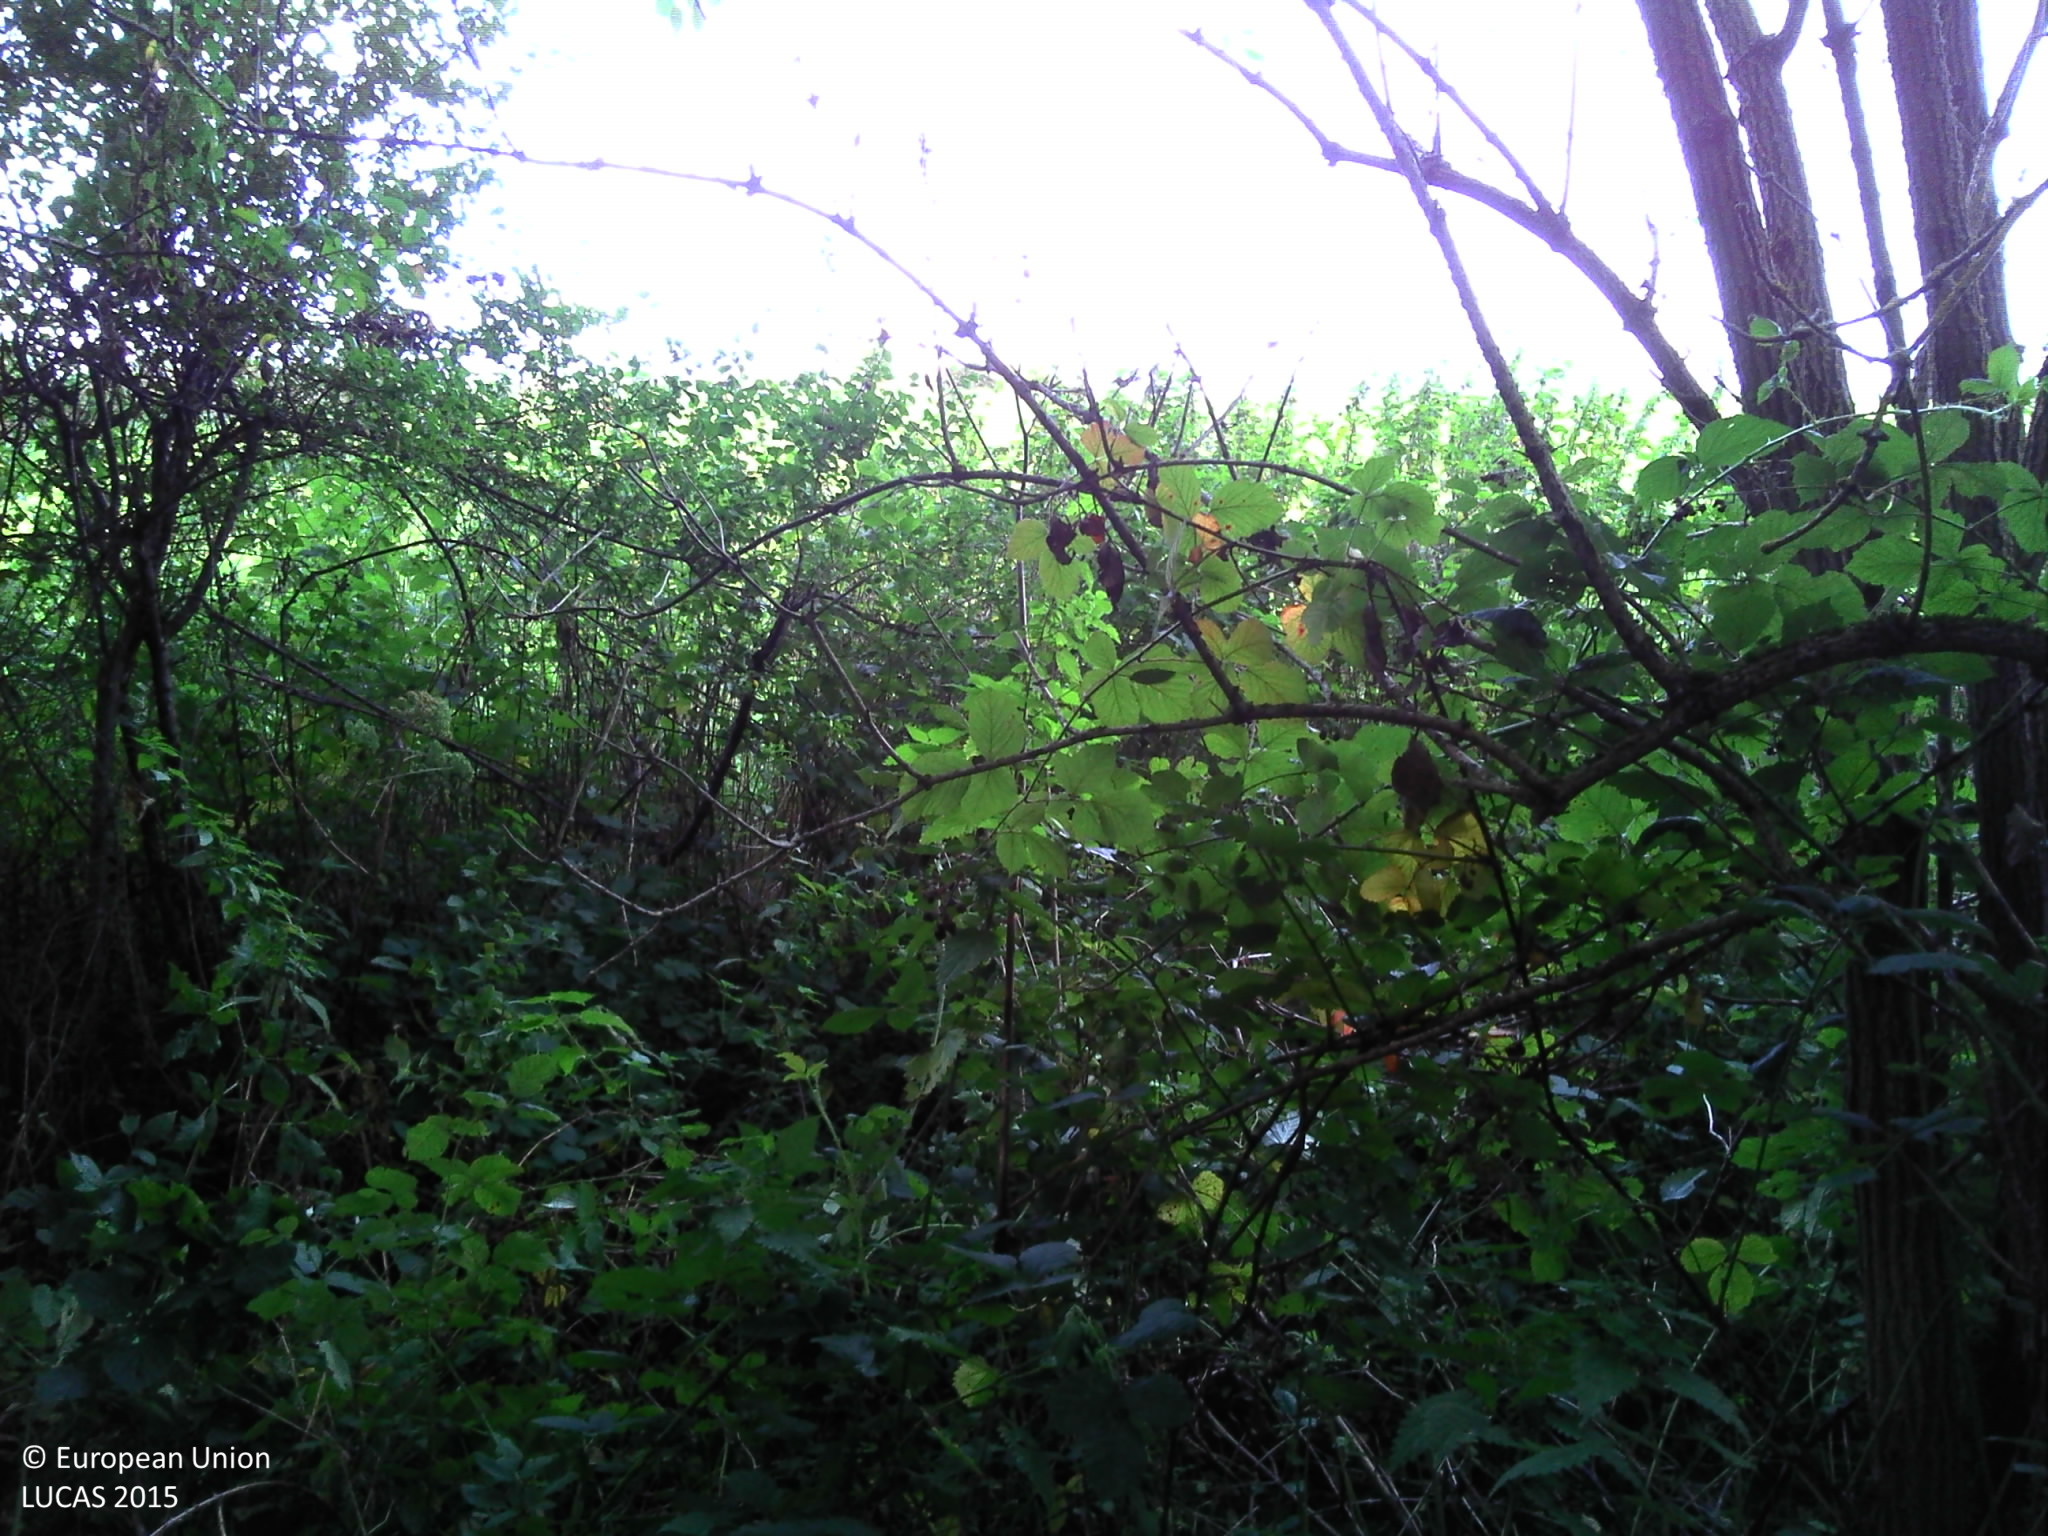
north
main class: Woodland
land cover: Broadleaved woodland
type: mesophytic deciduous forest
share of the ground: > 75 %
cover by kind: broadleaved forest trees 75 %, herbaceous plants 25 %
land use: Forestry
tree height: > 5 m
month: September
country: FR
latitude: 46.1633
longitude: 2.8099
